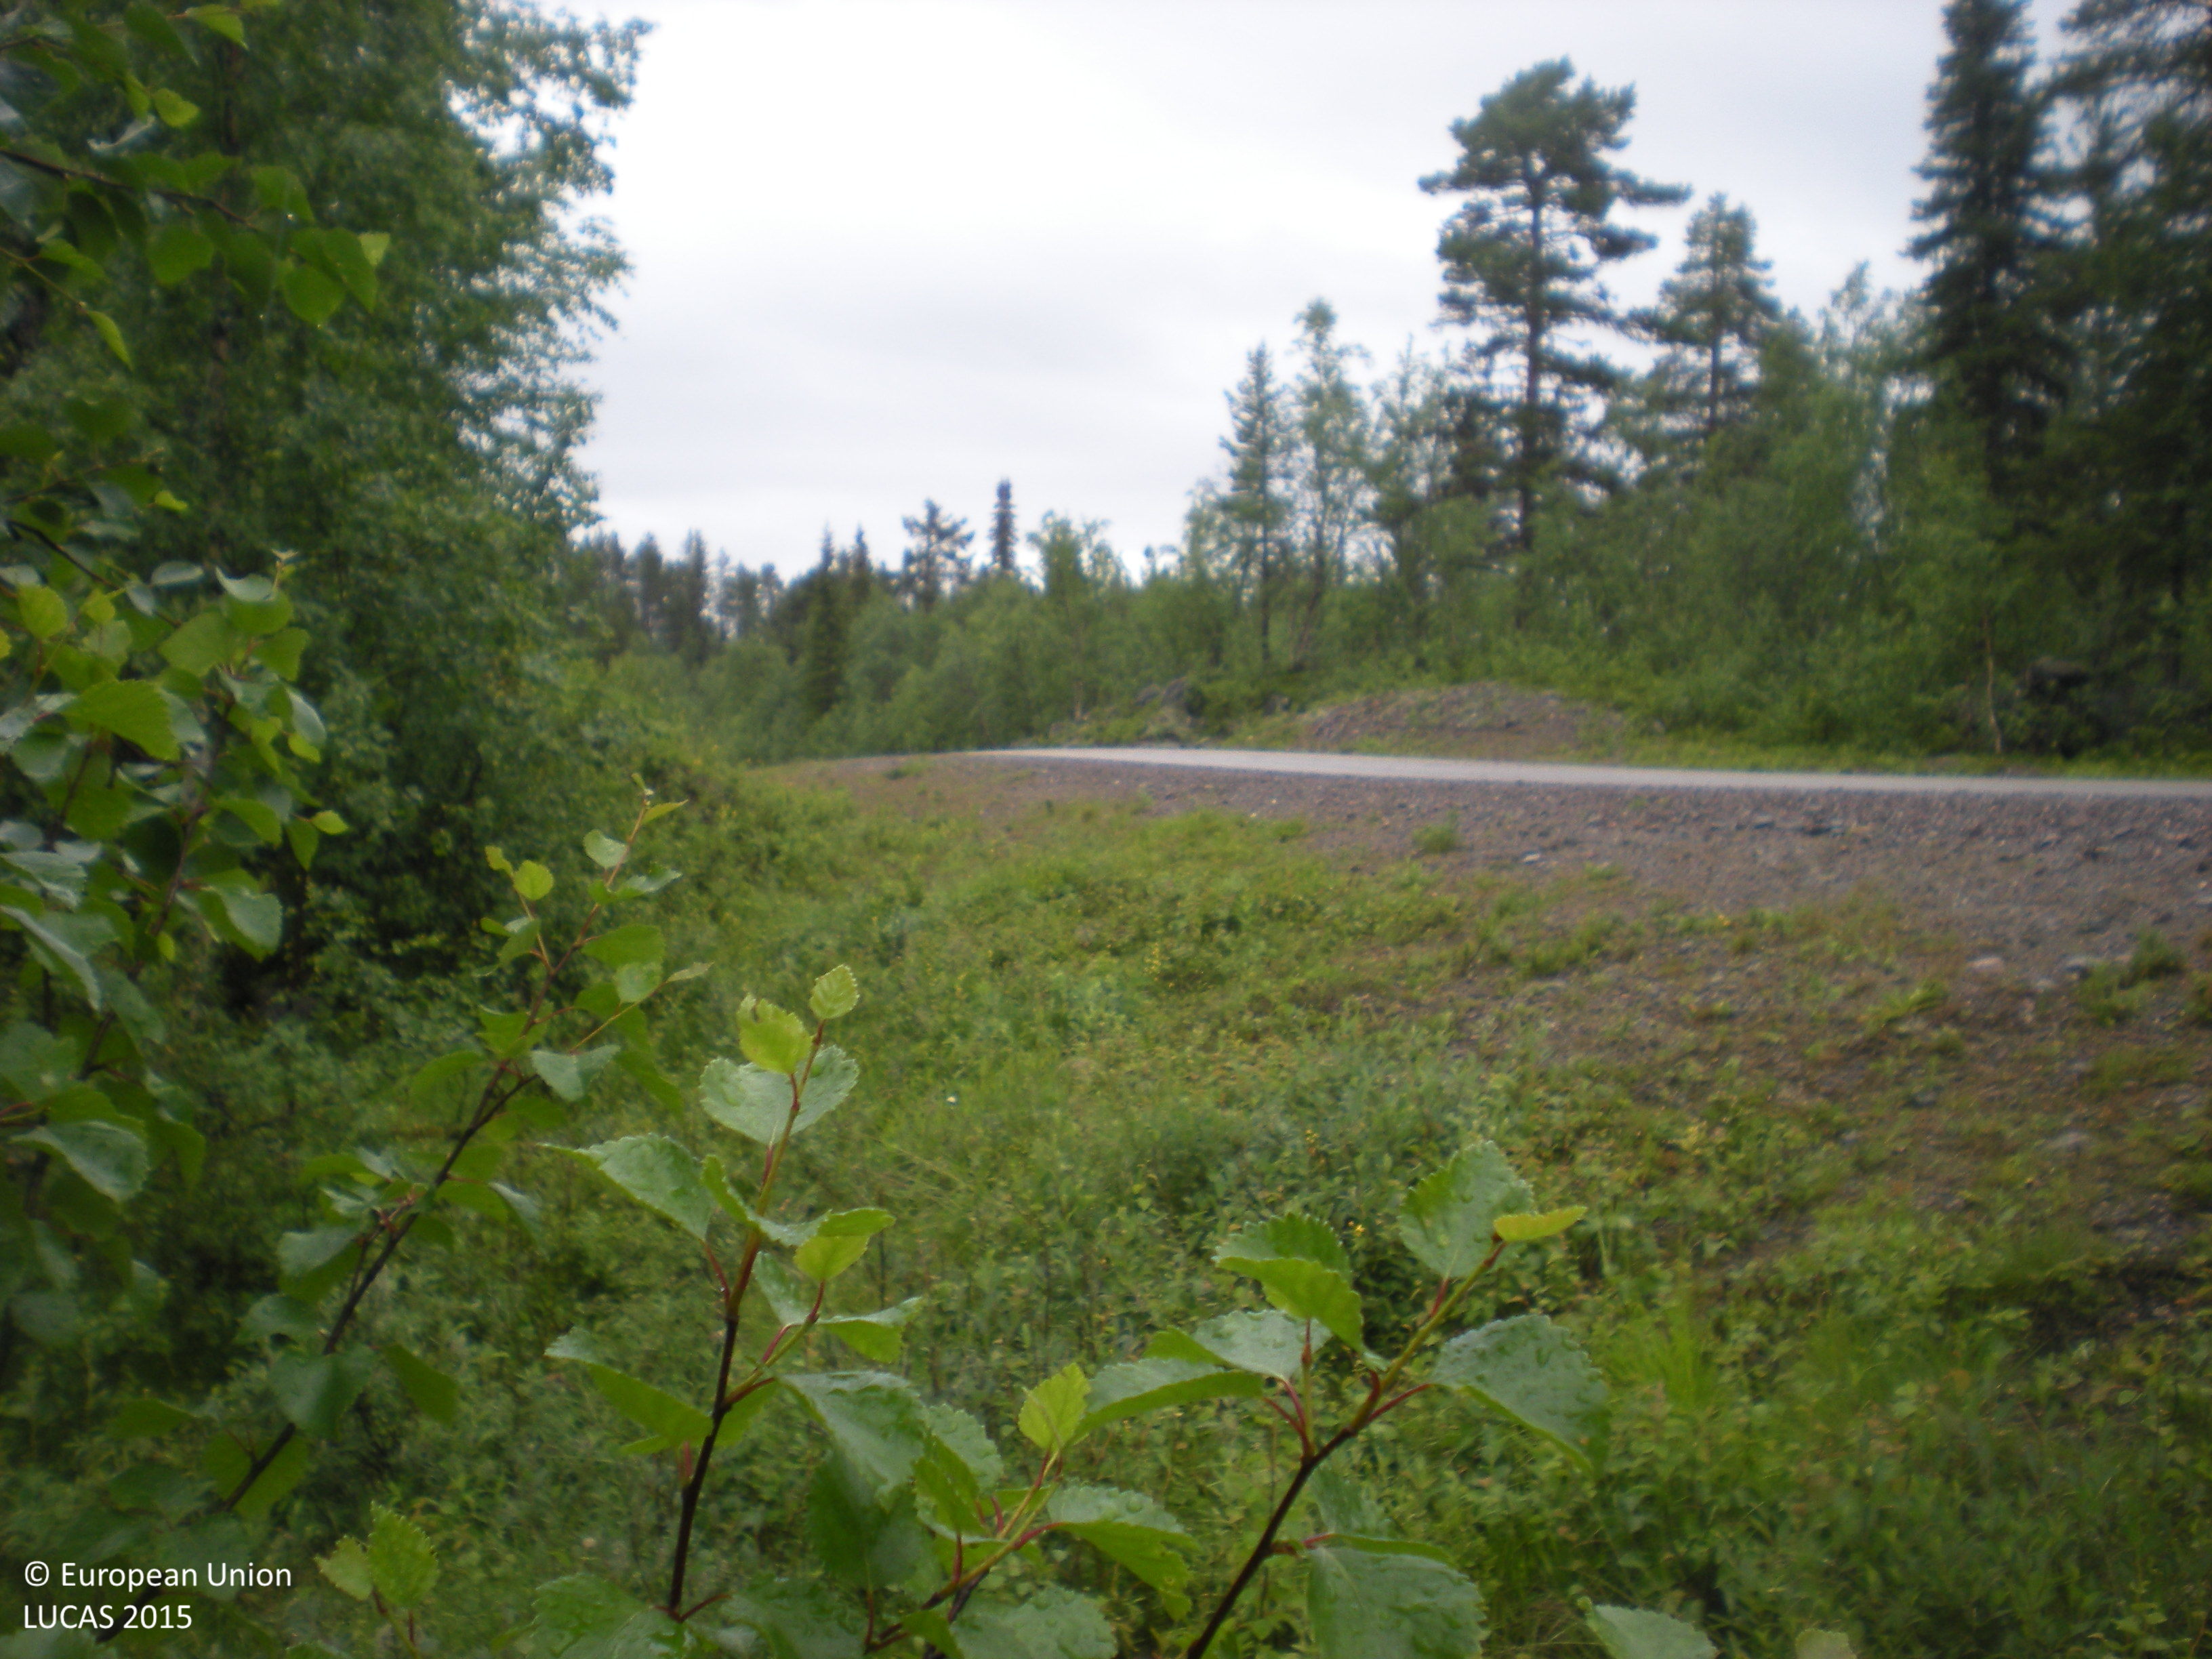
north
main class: Woodland
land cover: Broadleaved woodland
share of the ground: 25 - 50 %
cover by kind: broadleaved forest trees 40 %, shrubs 35 %, herbaceous plants 15 %, consolidated bare surface 10 %
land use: Forestry
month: August
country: SE
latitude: 66.3693
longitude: 17.7998
